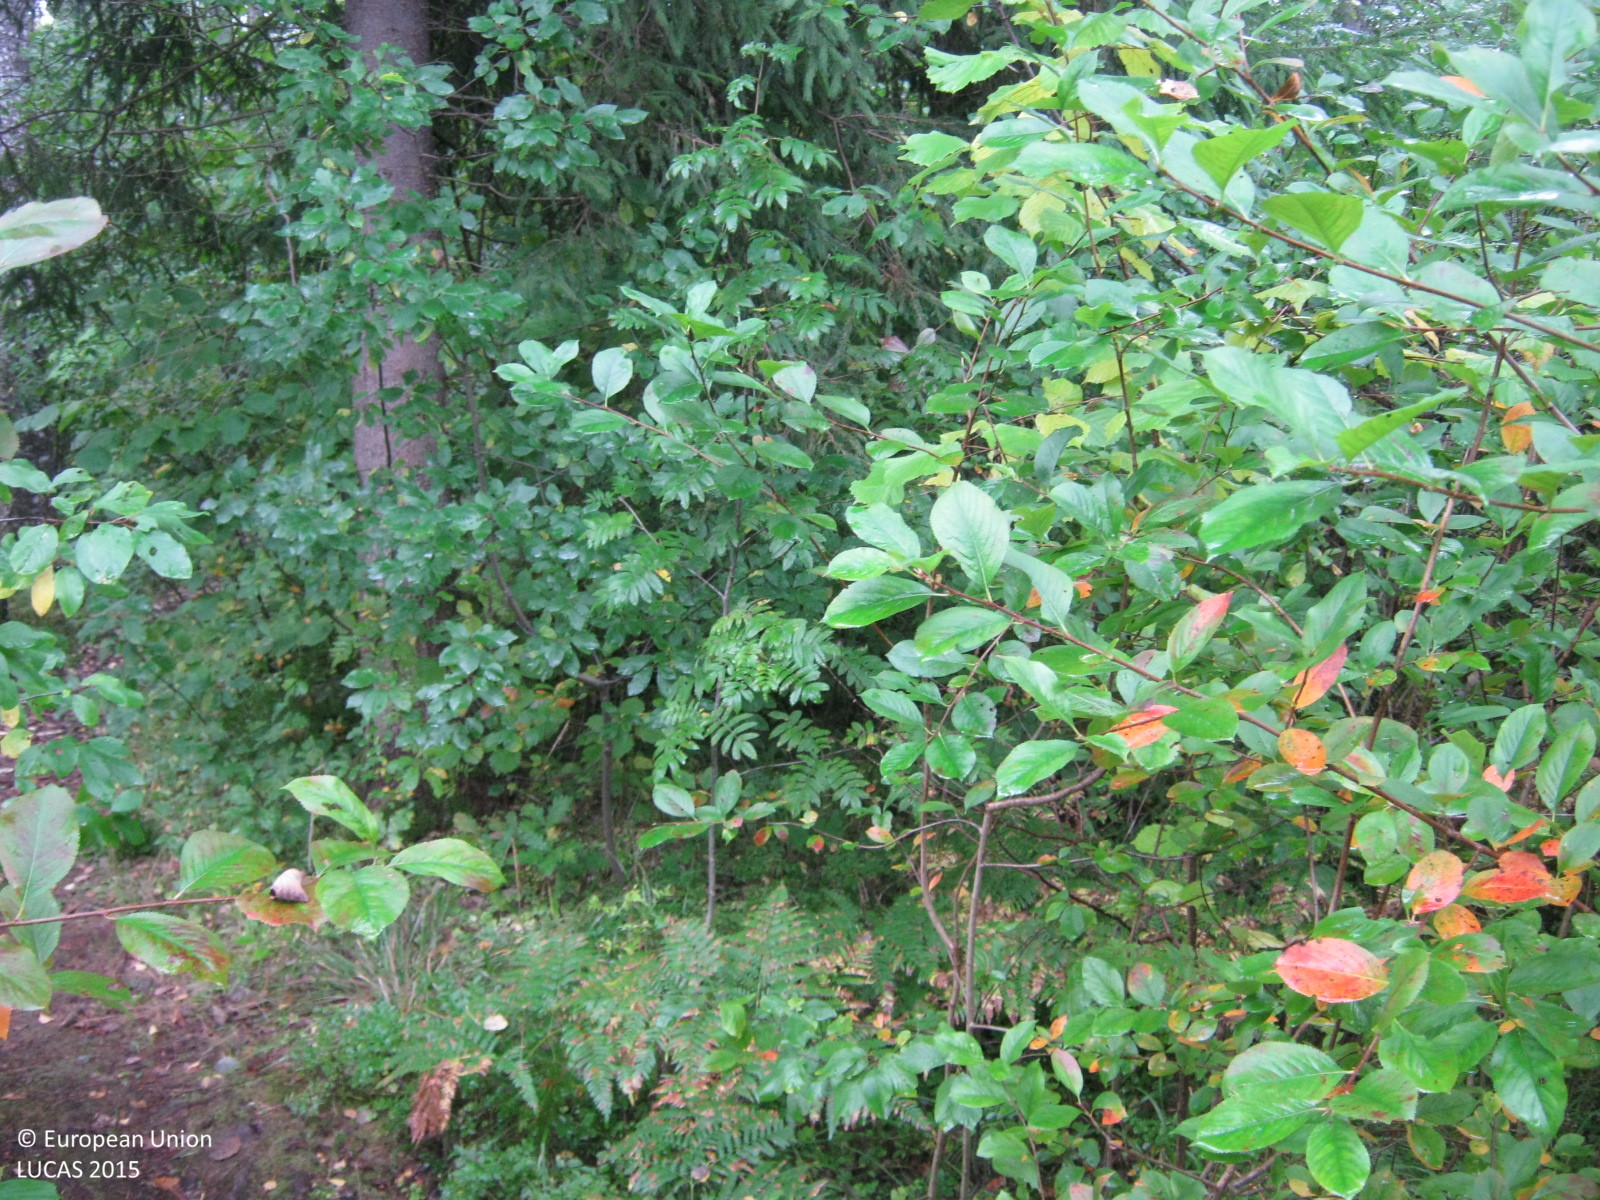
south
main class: Woodland
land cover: Broadleaved woodland
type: non-riverine alder, birch or aspen forest
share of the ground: 50 - 75 %
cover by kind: broadleaved forest trees 60 %, herbaceous plants 15 %, coniferous forest trees 10 %, shrubs 10 %, unconsolidated bare surface 5 %
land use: Forestry
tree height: > 5 m
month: September
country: LV
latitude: 57.2483
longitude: 24.4605
